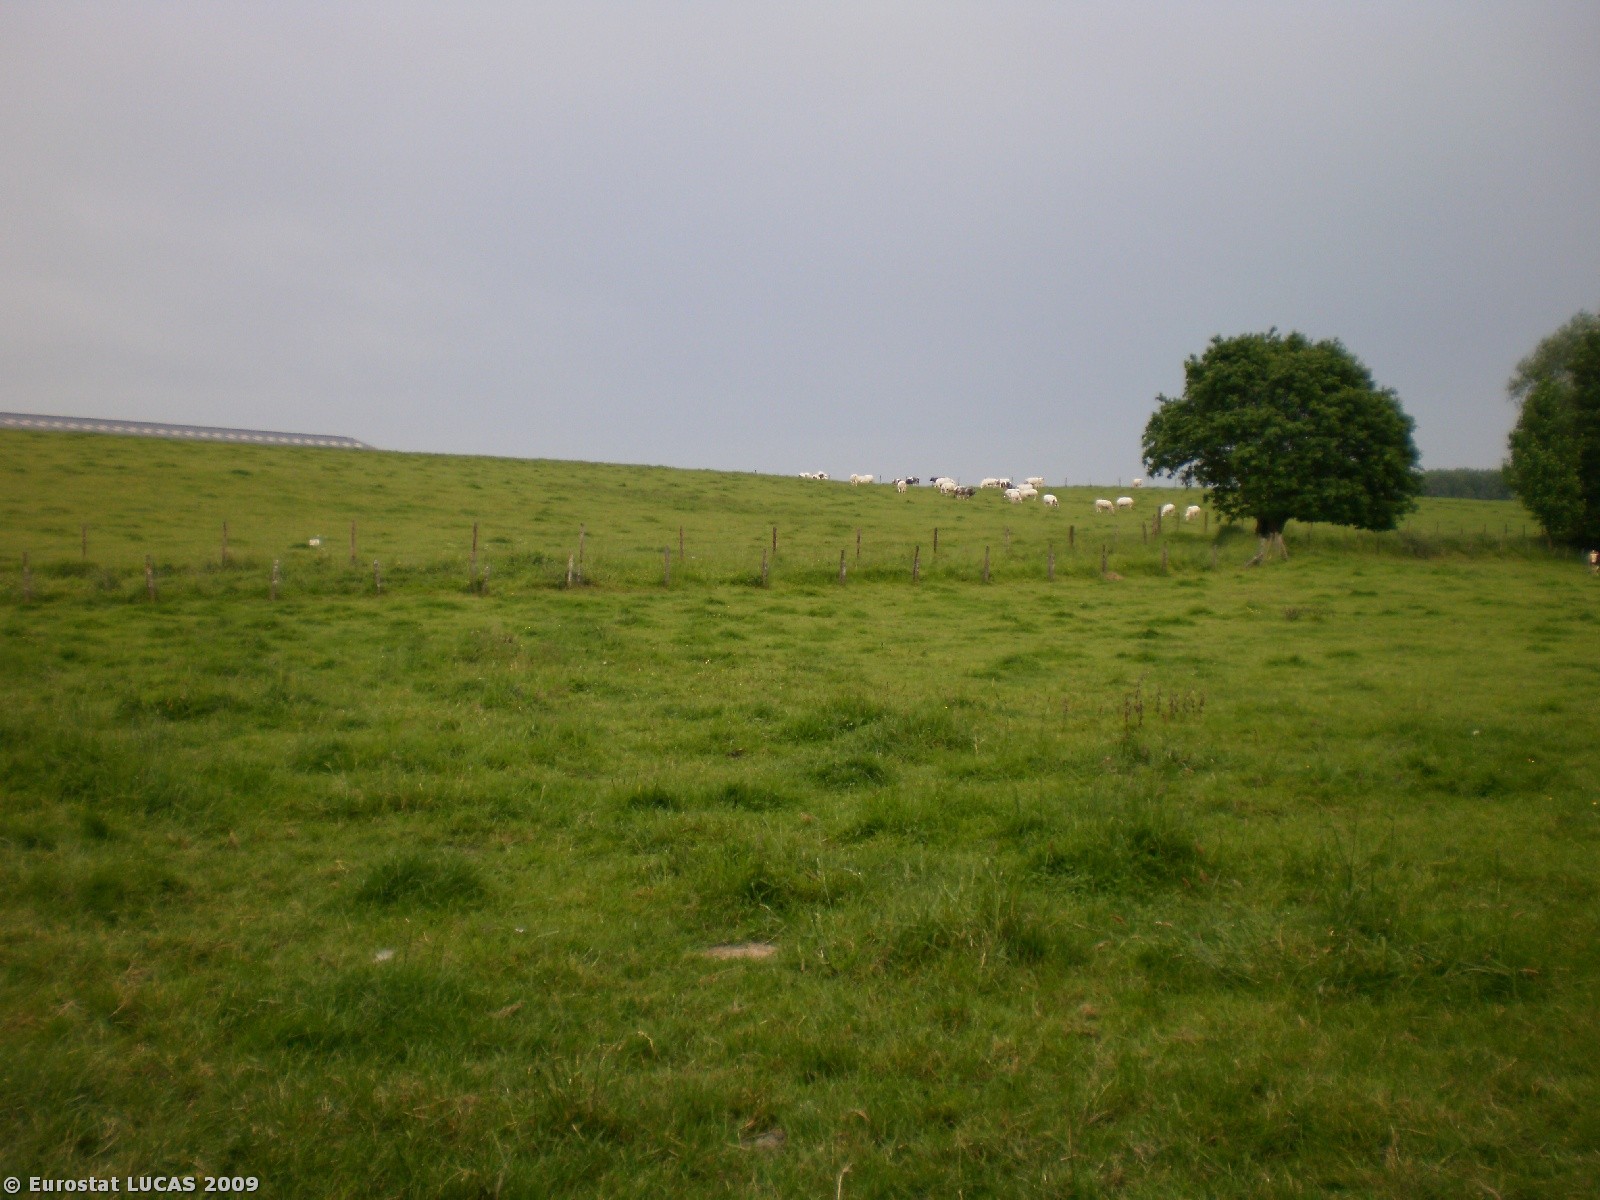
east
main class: Grassland
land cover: Grassland without tree/shrub cover
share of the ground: > 75 %
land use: Agriculture (excluding fallow land and kitchen gardens)
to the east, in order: Grassland without tree/shrub cover; Bare land; Fences; Tracks; Fences; Bare land; Grassland without tree/shrub cover; Artificial constructions in urban areas
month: May
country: BE
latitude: 50.6817
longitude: 3.7803
